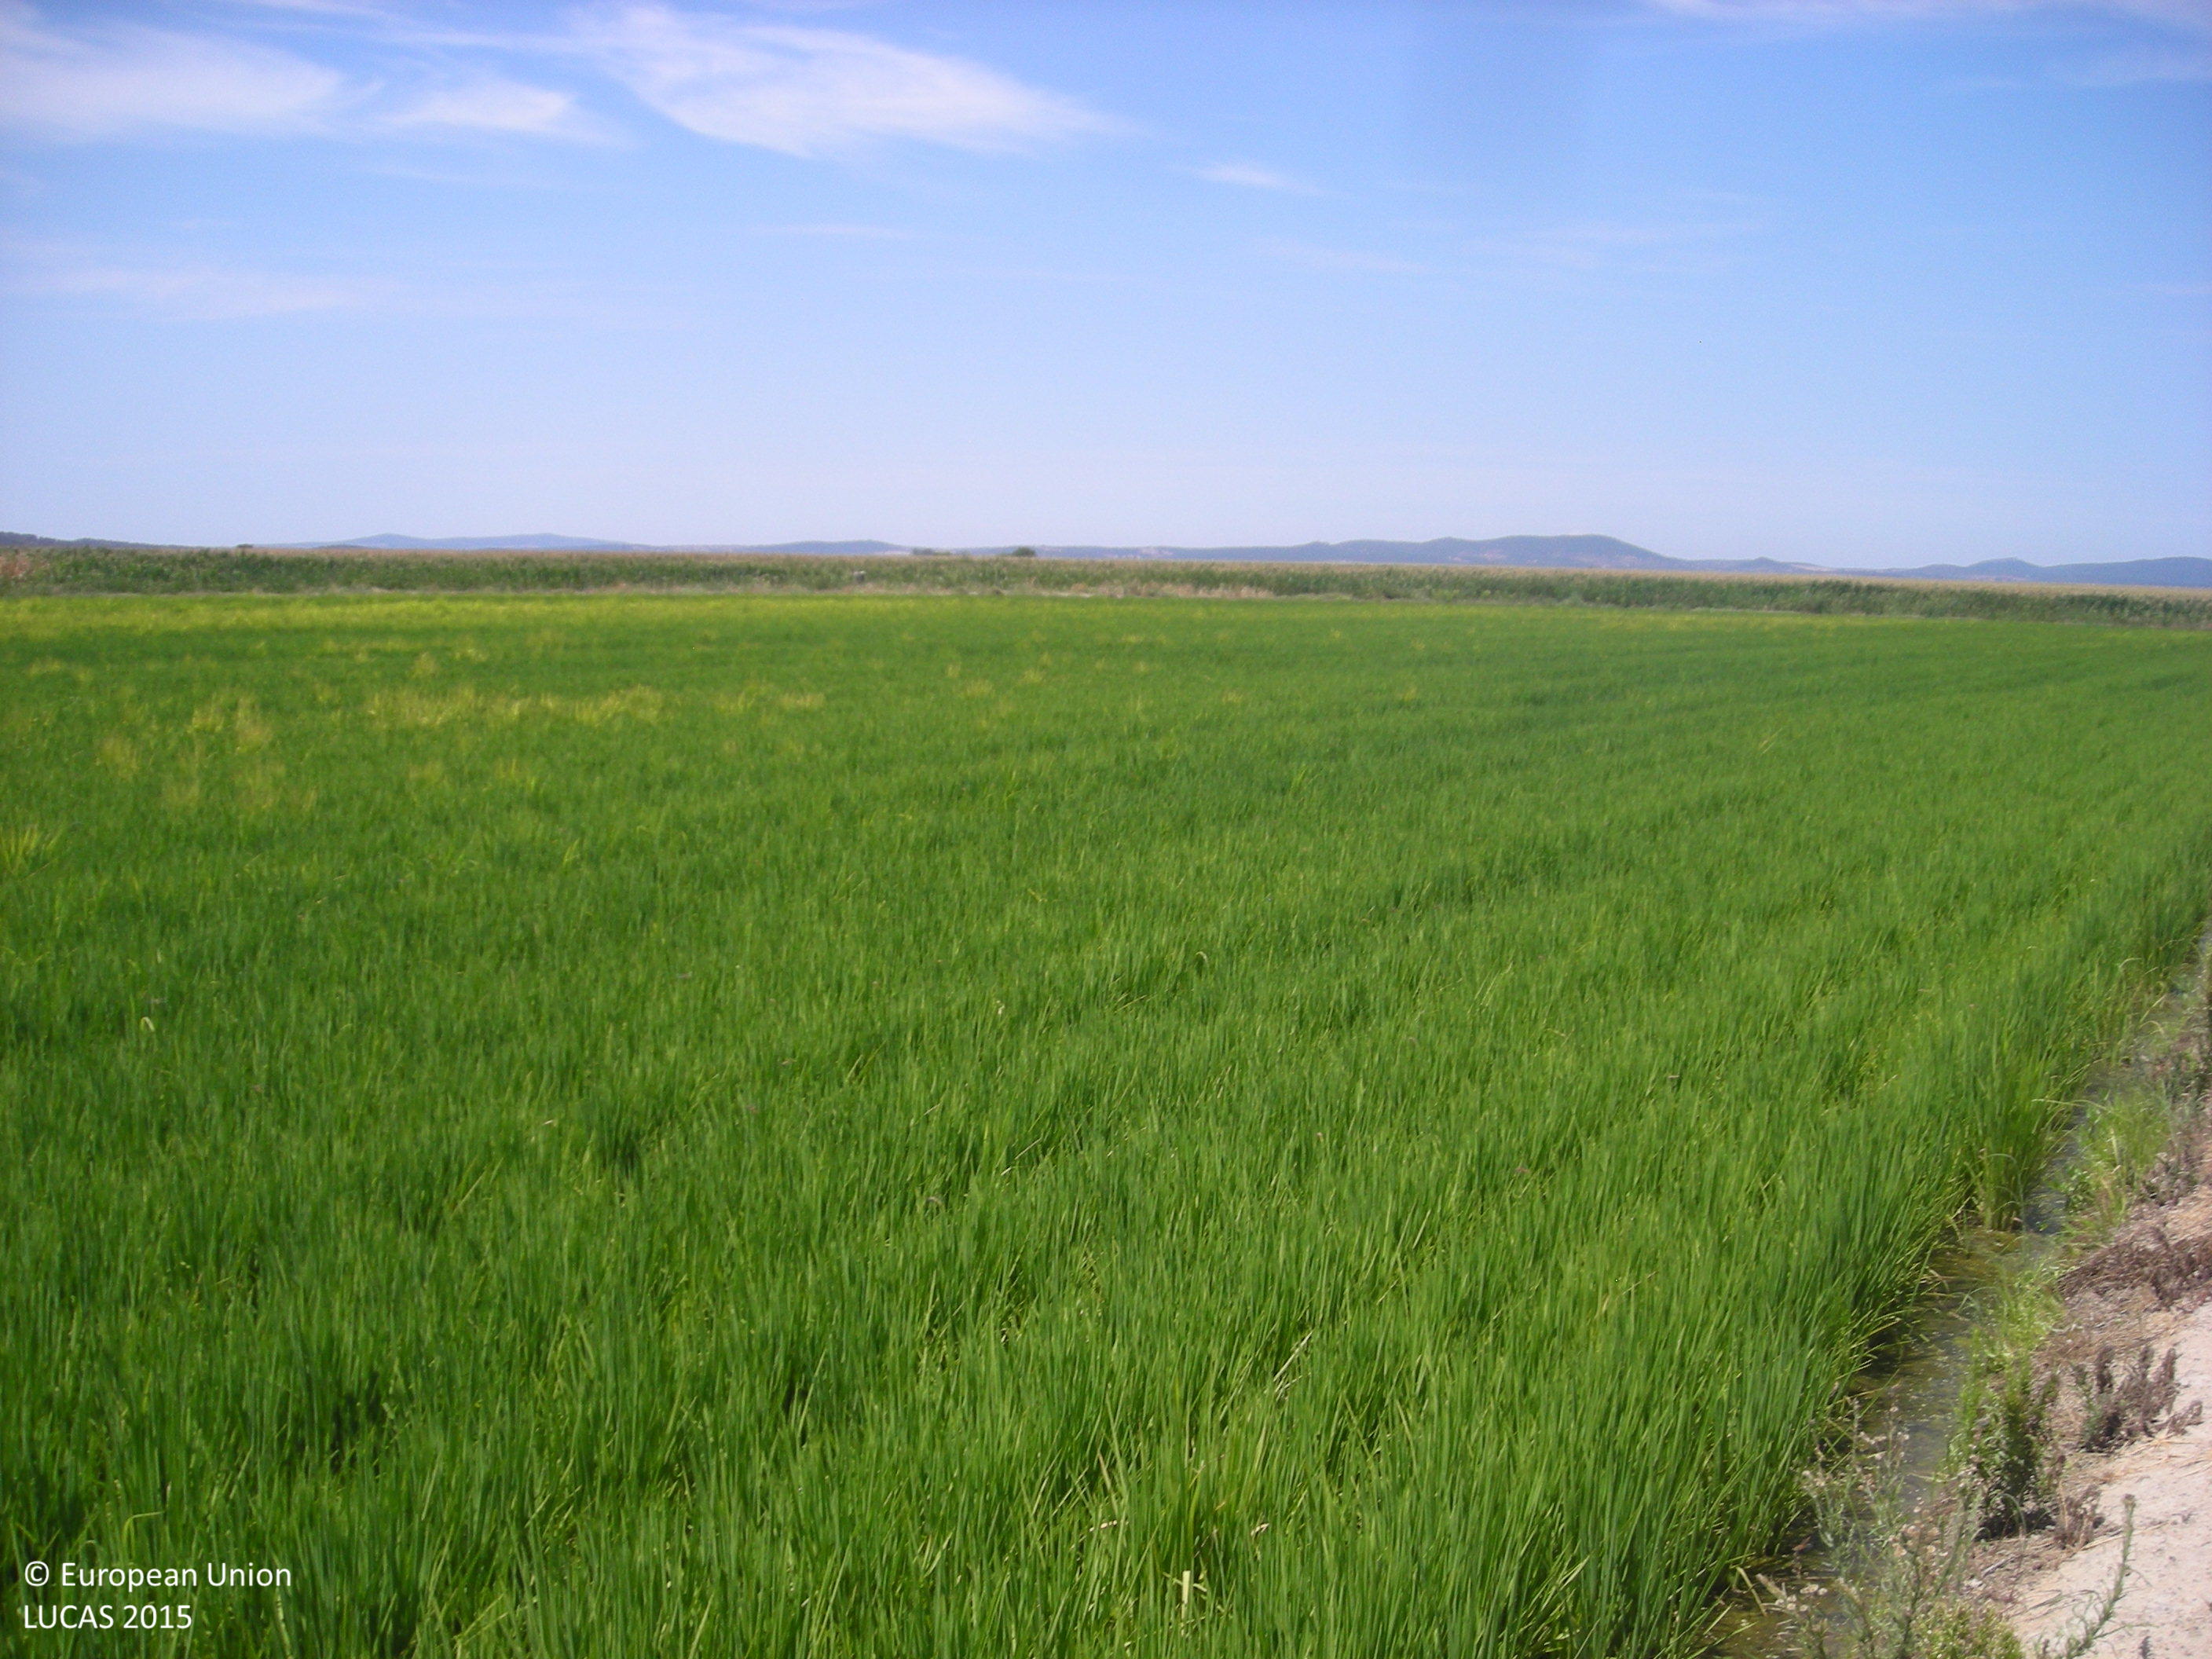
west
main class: Cropland
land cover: Maize
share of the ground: > 75 %
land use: Agriculture (excluding fallow land and kitchen gardens)
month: July
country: ES
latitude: 39.0430
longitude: -5.9621
